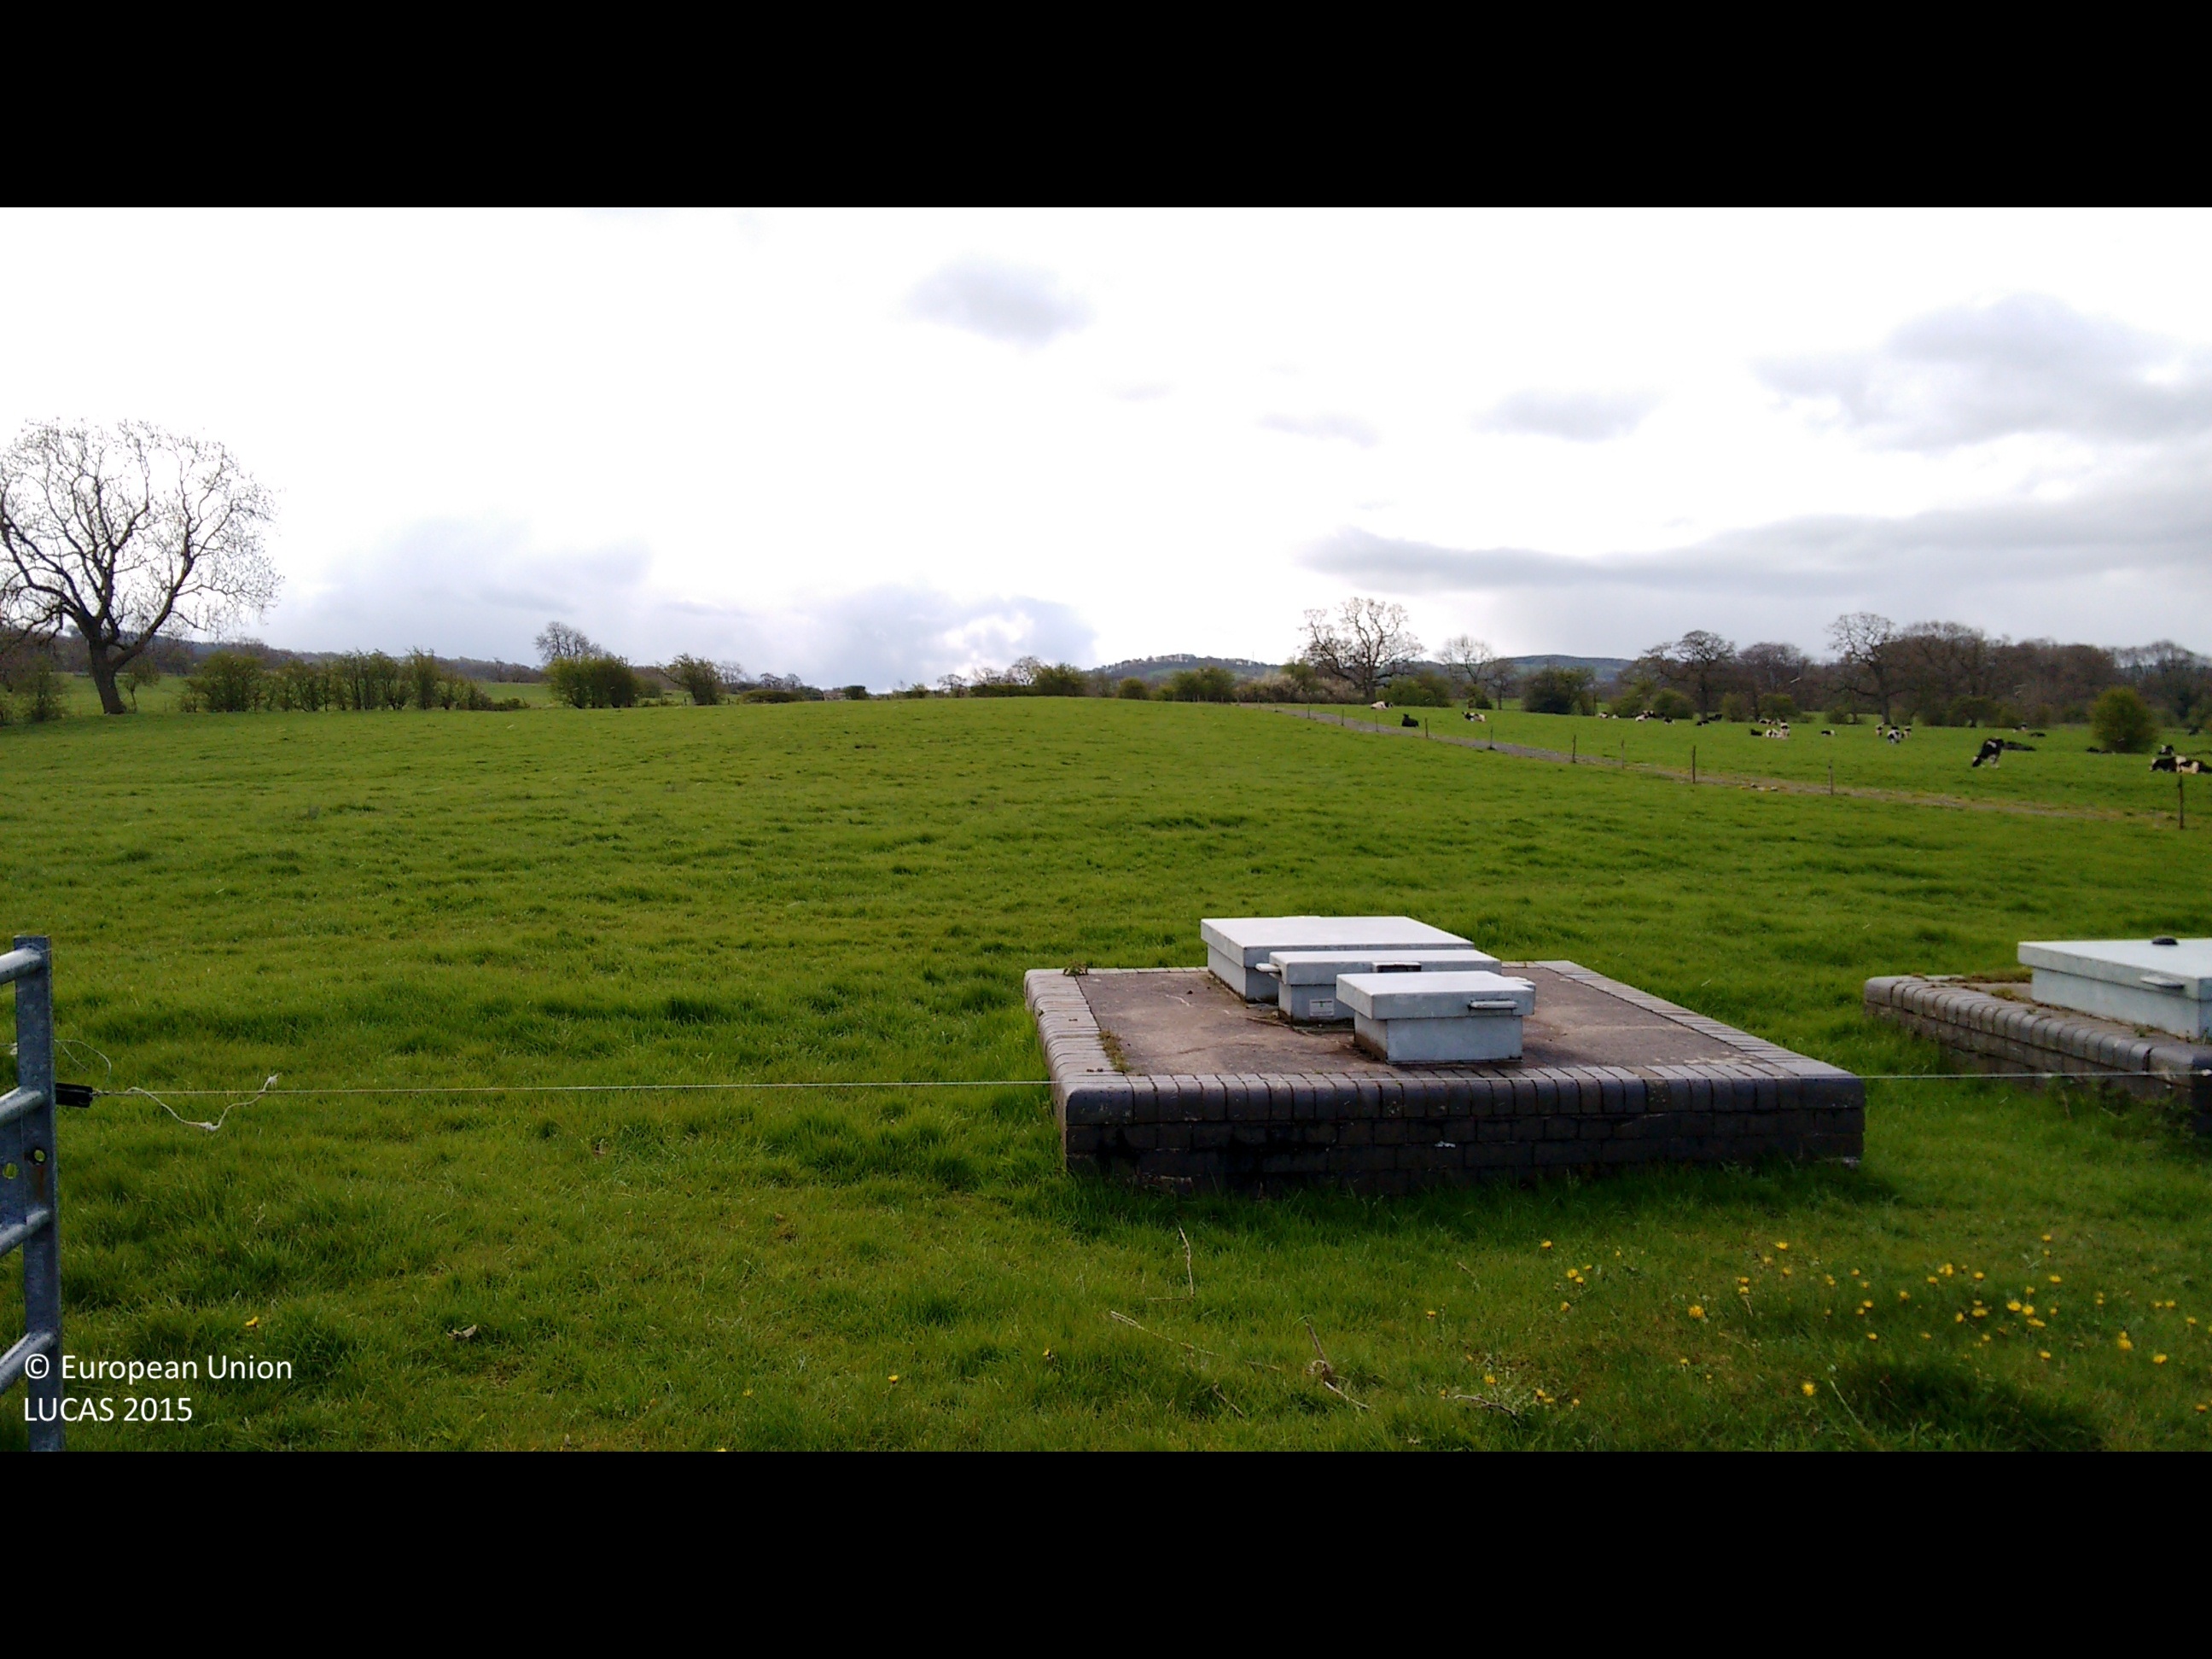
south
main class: Grassland
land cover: Grassland without tree/shrub cover
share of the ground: > 75 %
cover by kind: herbaceous plants 100 %
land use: Agriculture (excluding fallow land and kitchen gardens)
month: April
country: GB
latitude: 53.8513
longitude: -2.4225
